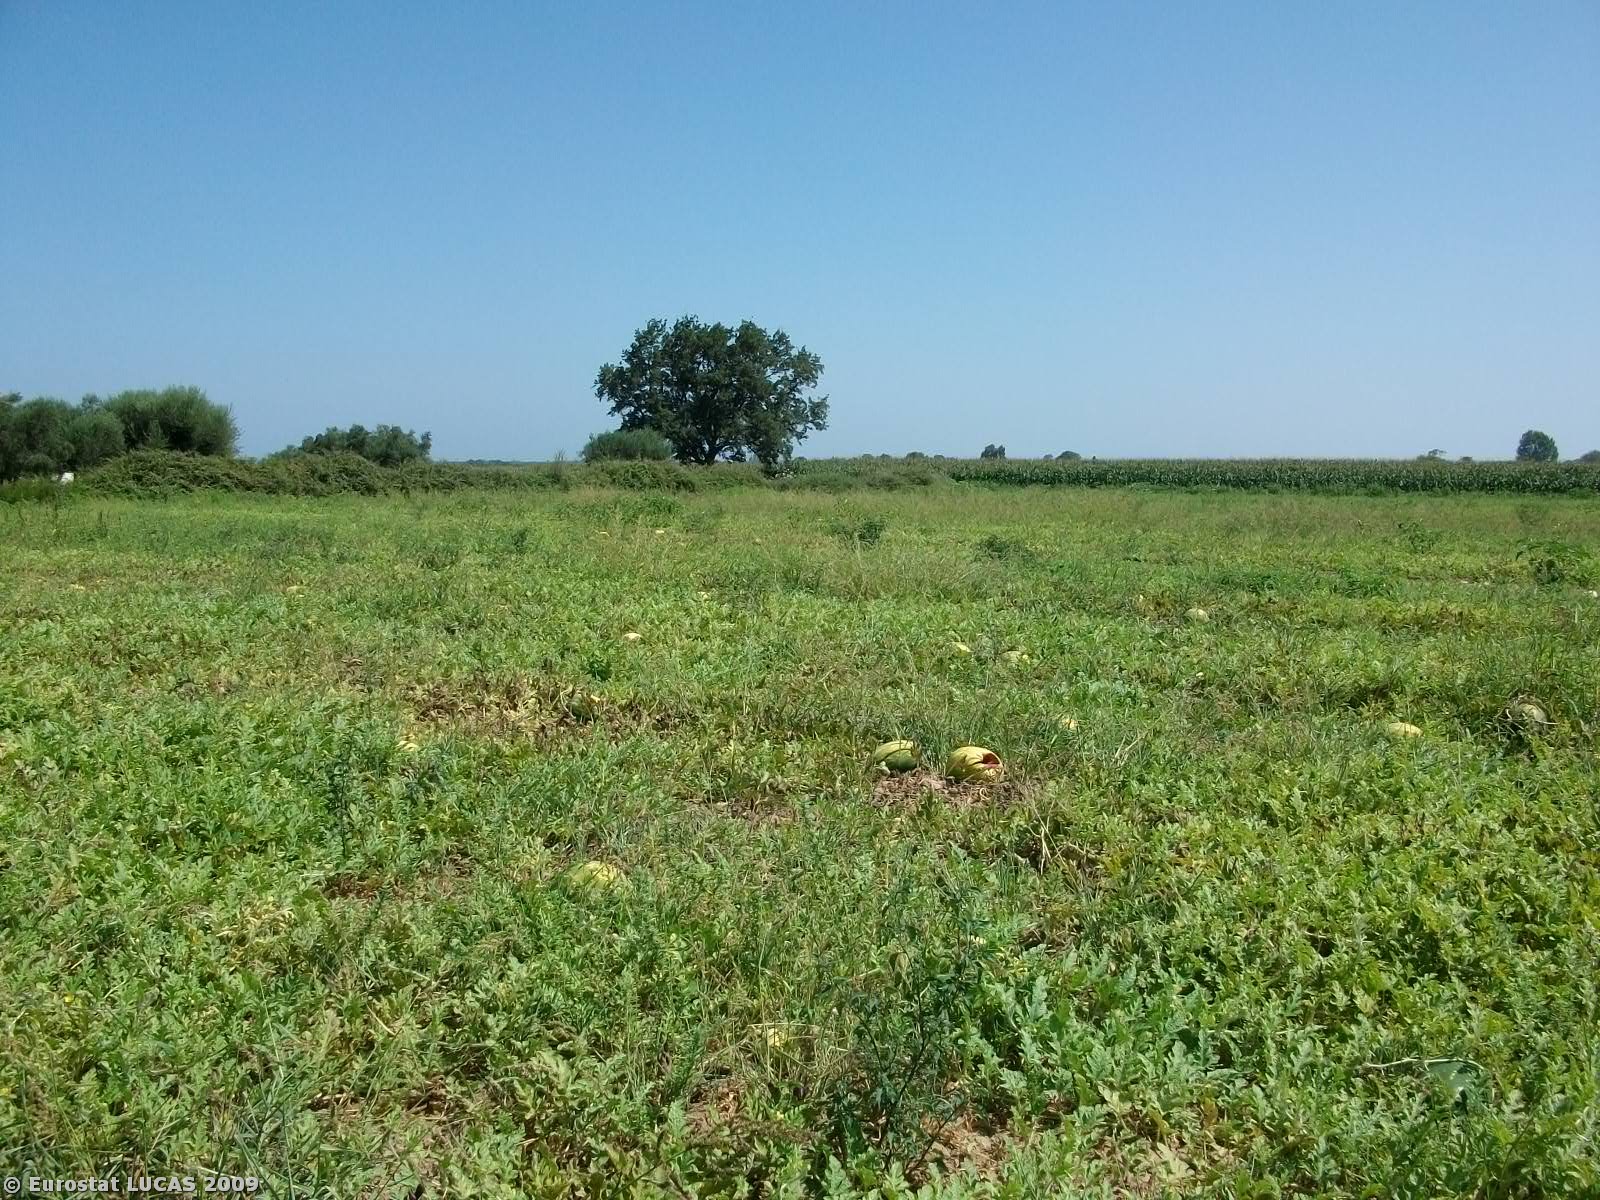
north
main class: Cropland
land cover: Other fresh vegetables
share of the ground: 50 - 75 %
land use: Agriculture (excluding fallow land and kitchen gardens)
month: July
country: GR
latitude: 38.0179
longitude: 21.3418
